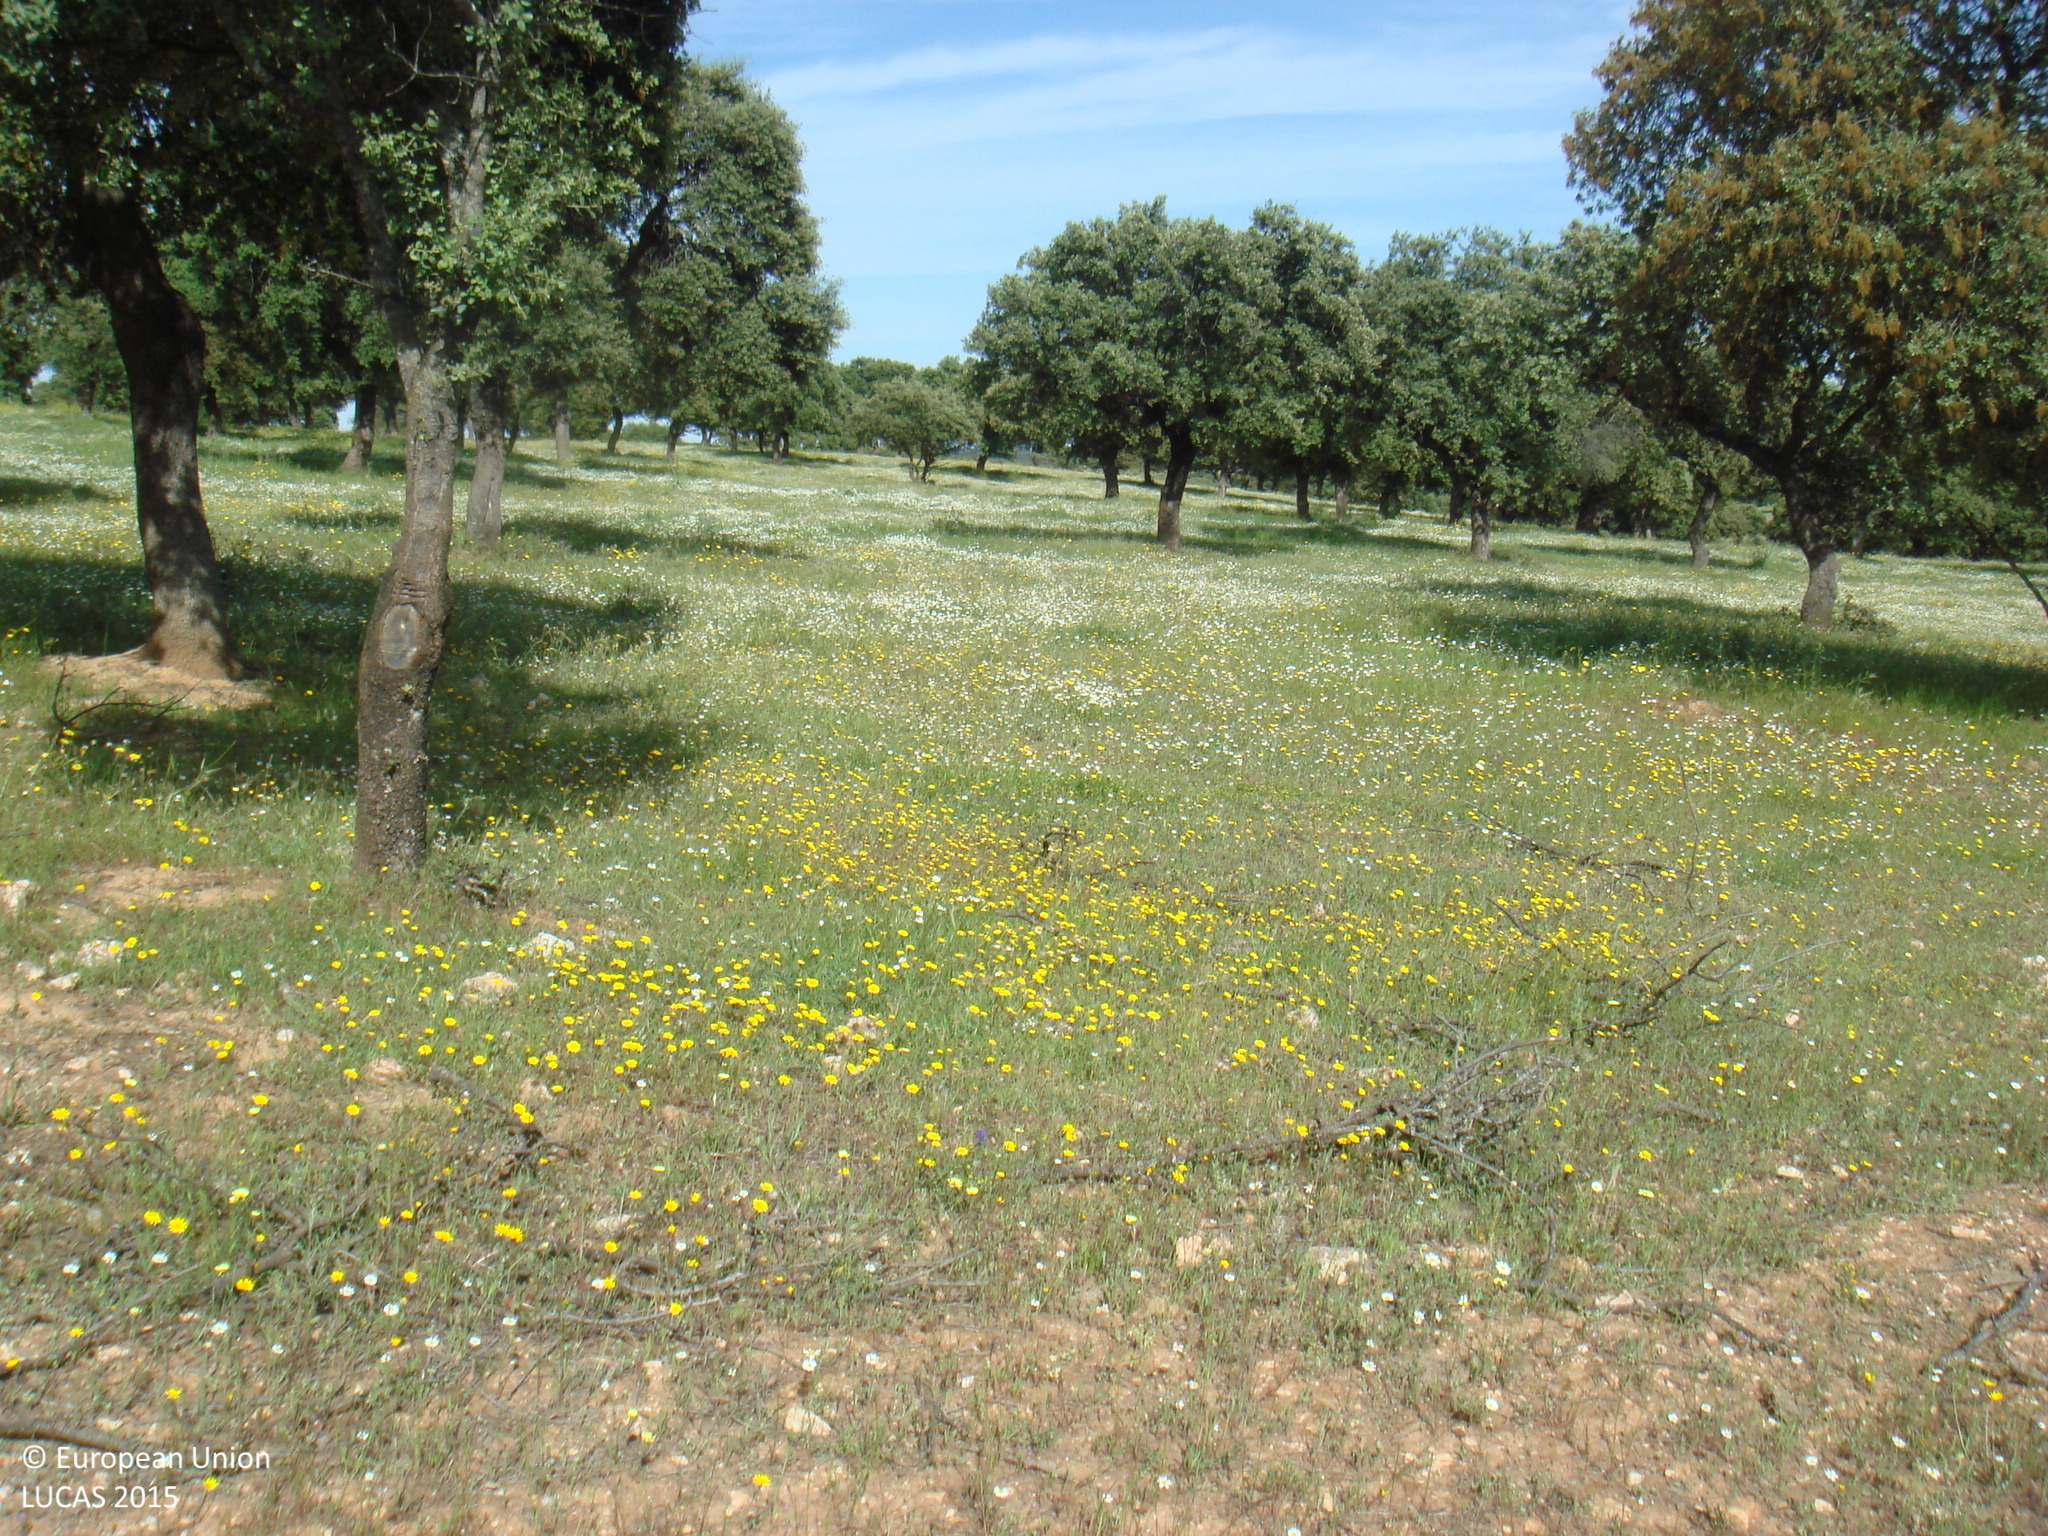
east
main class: Woodland
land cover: Broadleaved woodland
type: broadleaved evergreen forest
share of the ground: 10 - 25 %
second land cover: Oats
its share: > 75 %
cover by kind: herbaceous plants 85 %, broadleaved forest trees 15 %
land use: Forestry
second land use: Agriculture (excluding fallow land and kitchen gardens)
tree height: > 5 m
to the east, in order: Broadleaved woodland; Oats; Shruby margins; Fences; Shruby margins; Broadleaved woodland
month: April
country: ES
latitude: 38.4094
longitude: -5.1101
